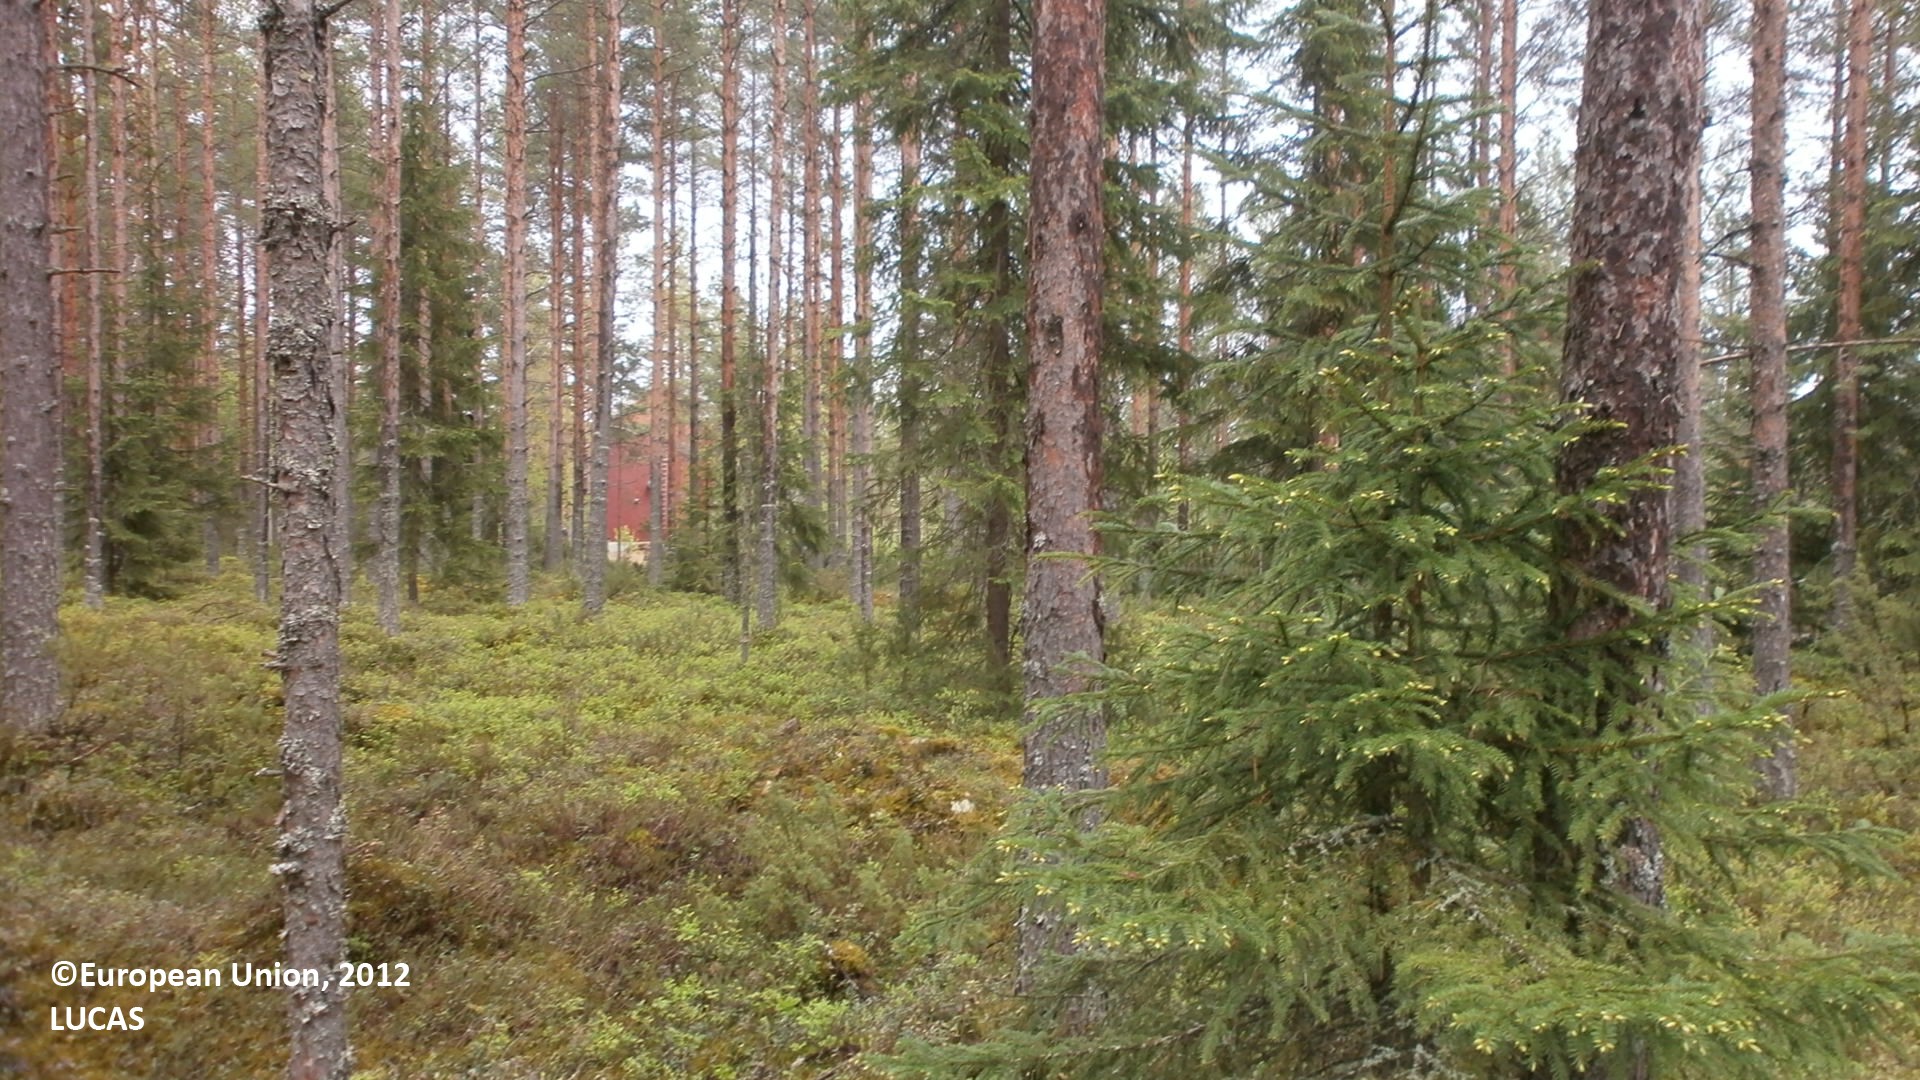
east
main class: Woodland
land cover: Pine dominated coniferous woodland
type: hemiboreal forest and nemoral coniferous forest and mixed broadleaved-coniferous forest
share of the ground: 25 - 50 %
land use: Forestry
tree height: > 5 m
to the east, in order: Pine dominated coniferous woodland; Tracks; Pine dominated coniferous woodland; Ditches and canals; Grass margins; Paved roads, cycling and walking lanes; Grass margins; Ditches and canals; Electric lines; Pine dominated coniferous woodland; Artificial constructions in urban areas; Pine dominated coniferous woodland; Spruce dominated coniferous woodland; Pine dominated coniferous woodland; Other coniferous woodland
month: June
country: FI
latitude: 64.0178
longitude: 26.0462
